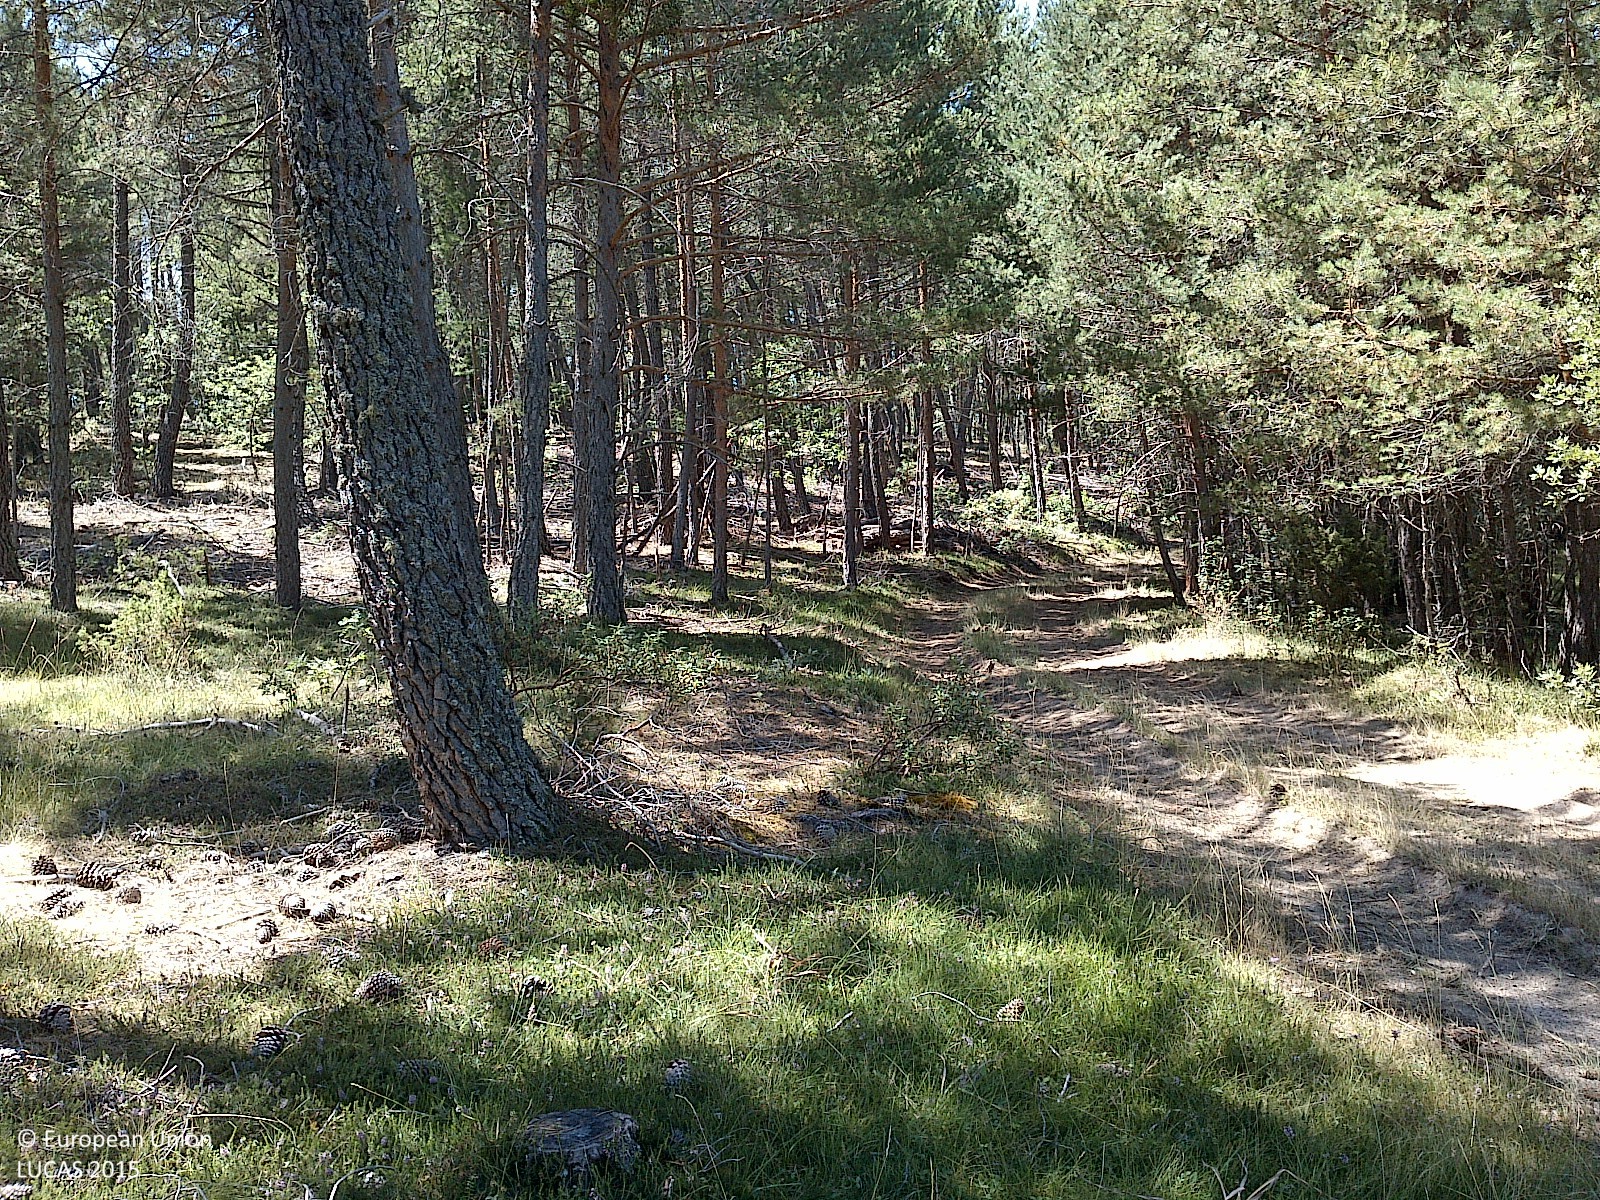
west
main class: Woodland
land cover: Pine dominated coniferous woodland
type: coniferous forest of the mediterranean region
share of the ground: > 75 %
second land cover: Grassland without tree/shrub cover
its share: 50 - 75 %
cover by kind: coniferous forest trees 80 %, herbaceous plants 15 %, shrubs 5 %
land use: Forestry
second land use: Agriculture (excluding fallow land and kitchen gardens)
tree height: > 5 m
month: July
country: ES
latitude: 41.8812
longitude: -3.1708
